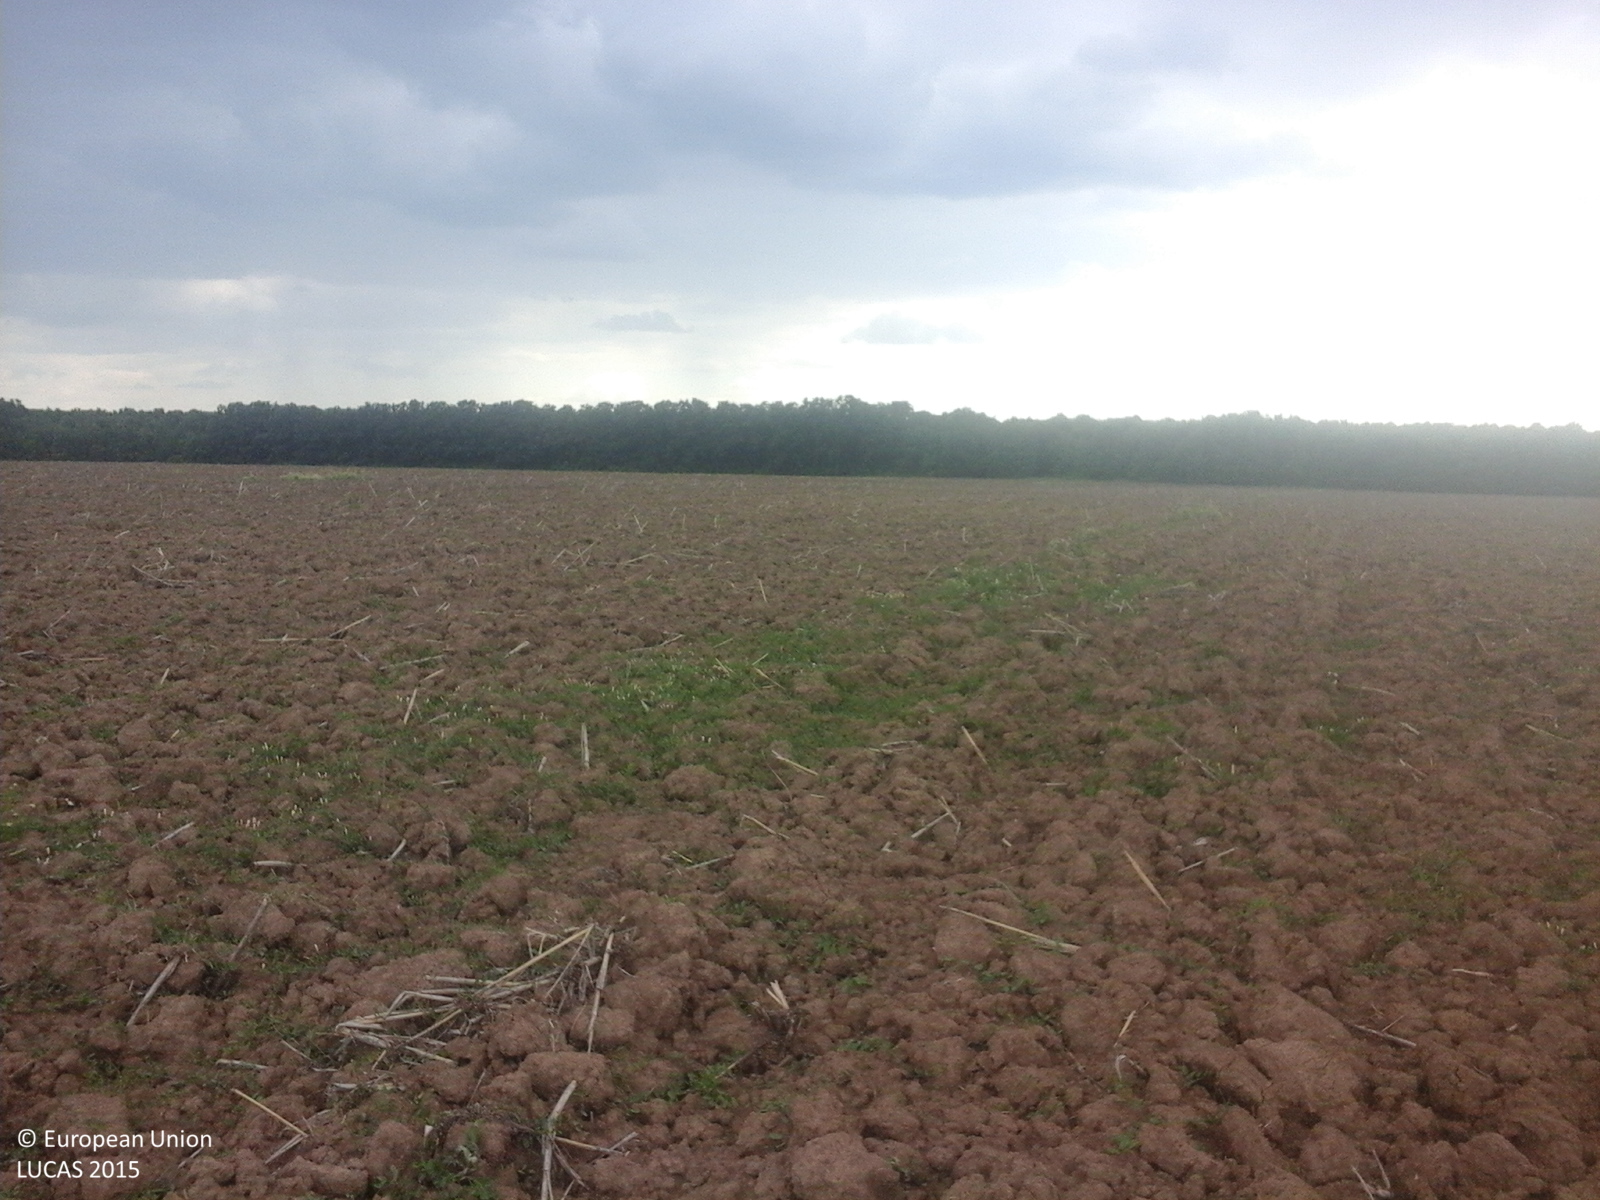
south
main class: Cropland
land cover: Other cereals
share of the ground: < 10 %
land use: Agriculture (excluding fallow land and kitchen gardens)
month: July
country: RO
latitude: 44.4805
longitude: 25.4931
